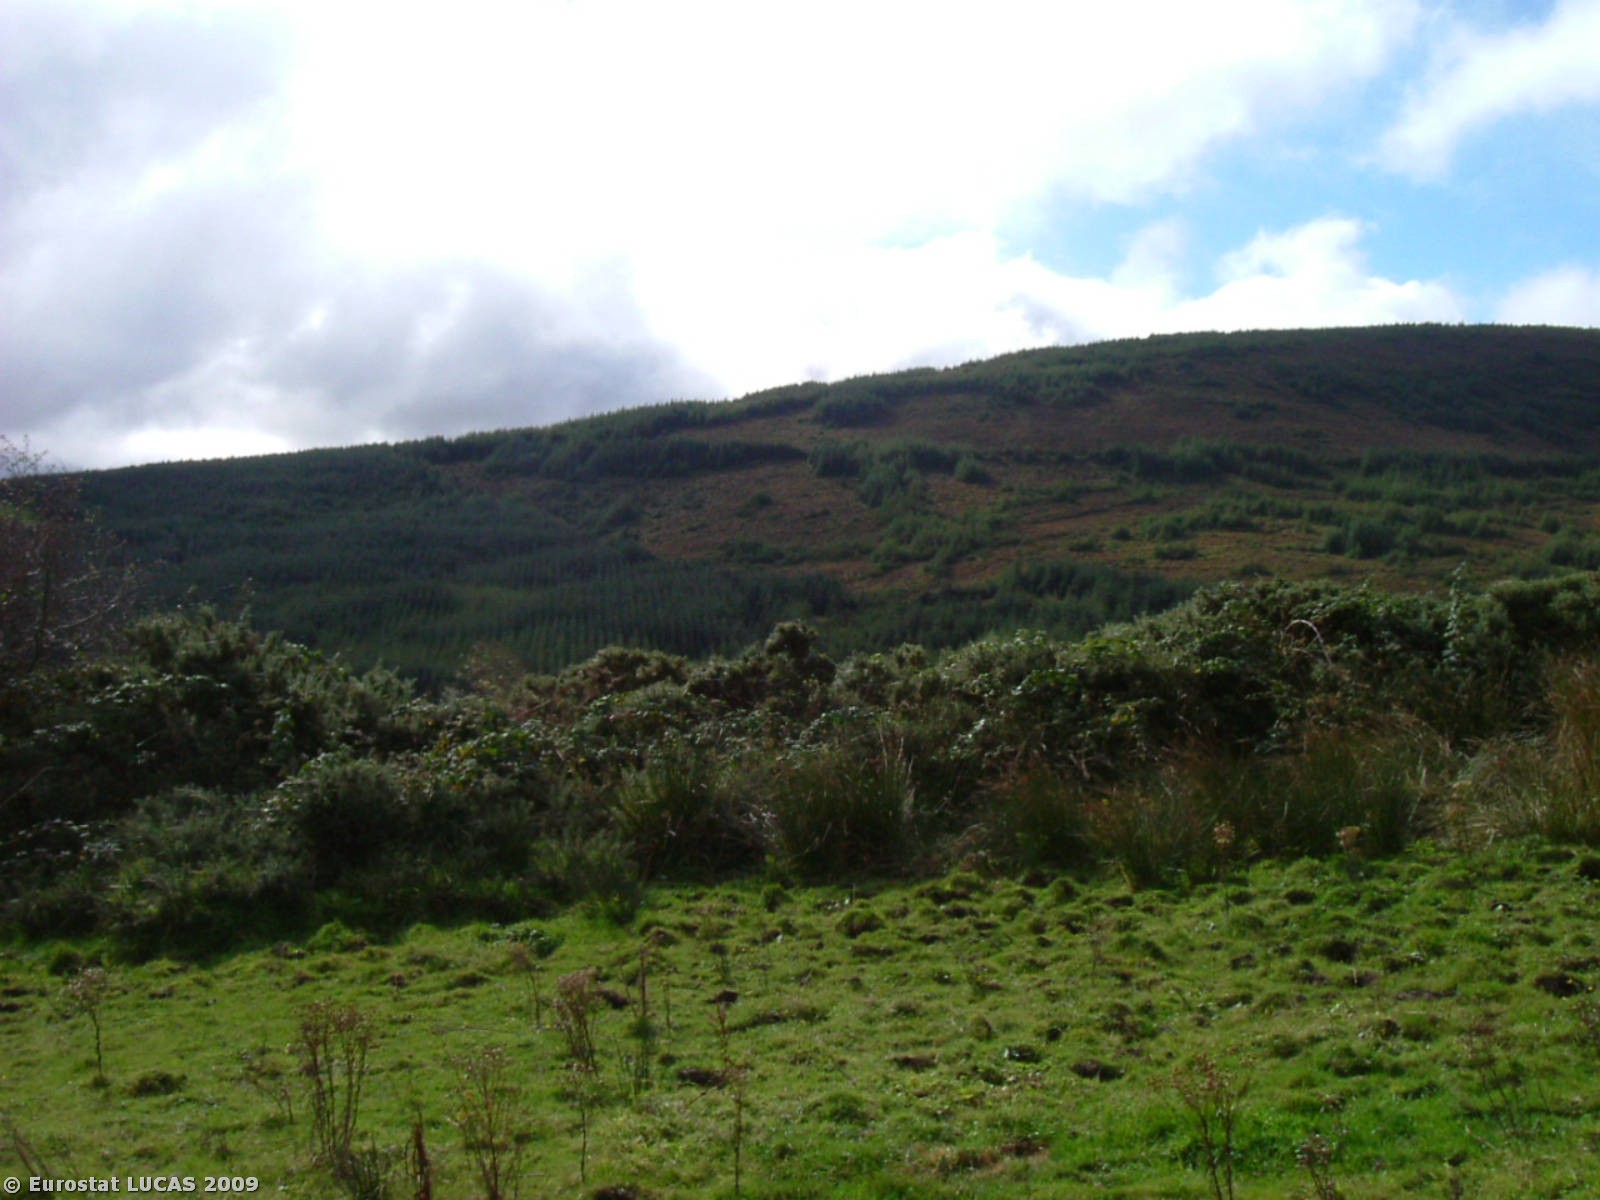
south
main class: Grassland
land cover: Grassland without tree/shrub cover
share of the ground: > 75 %
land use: Agriculture (excluding fallow land and kitchen gardens)
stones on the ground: < 10 %
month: September
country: IE
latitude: 52.7118
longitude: -8.1664
